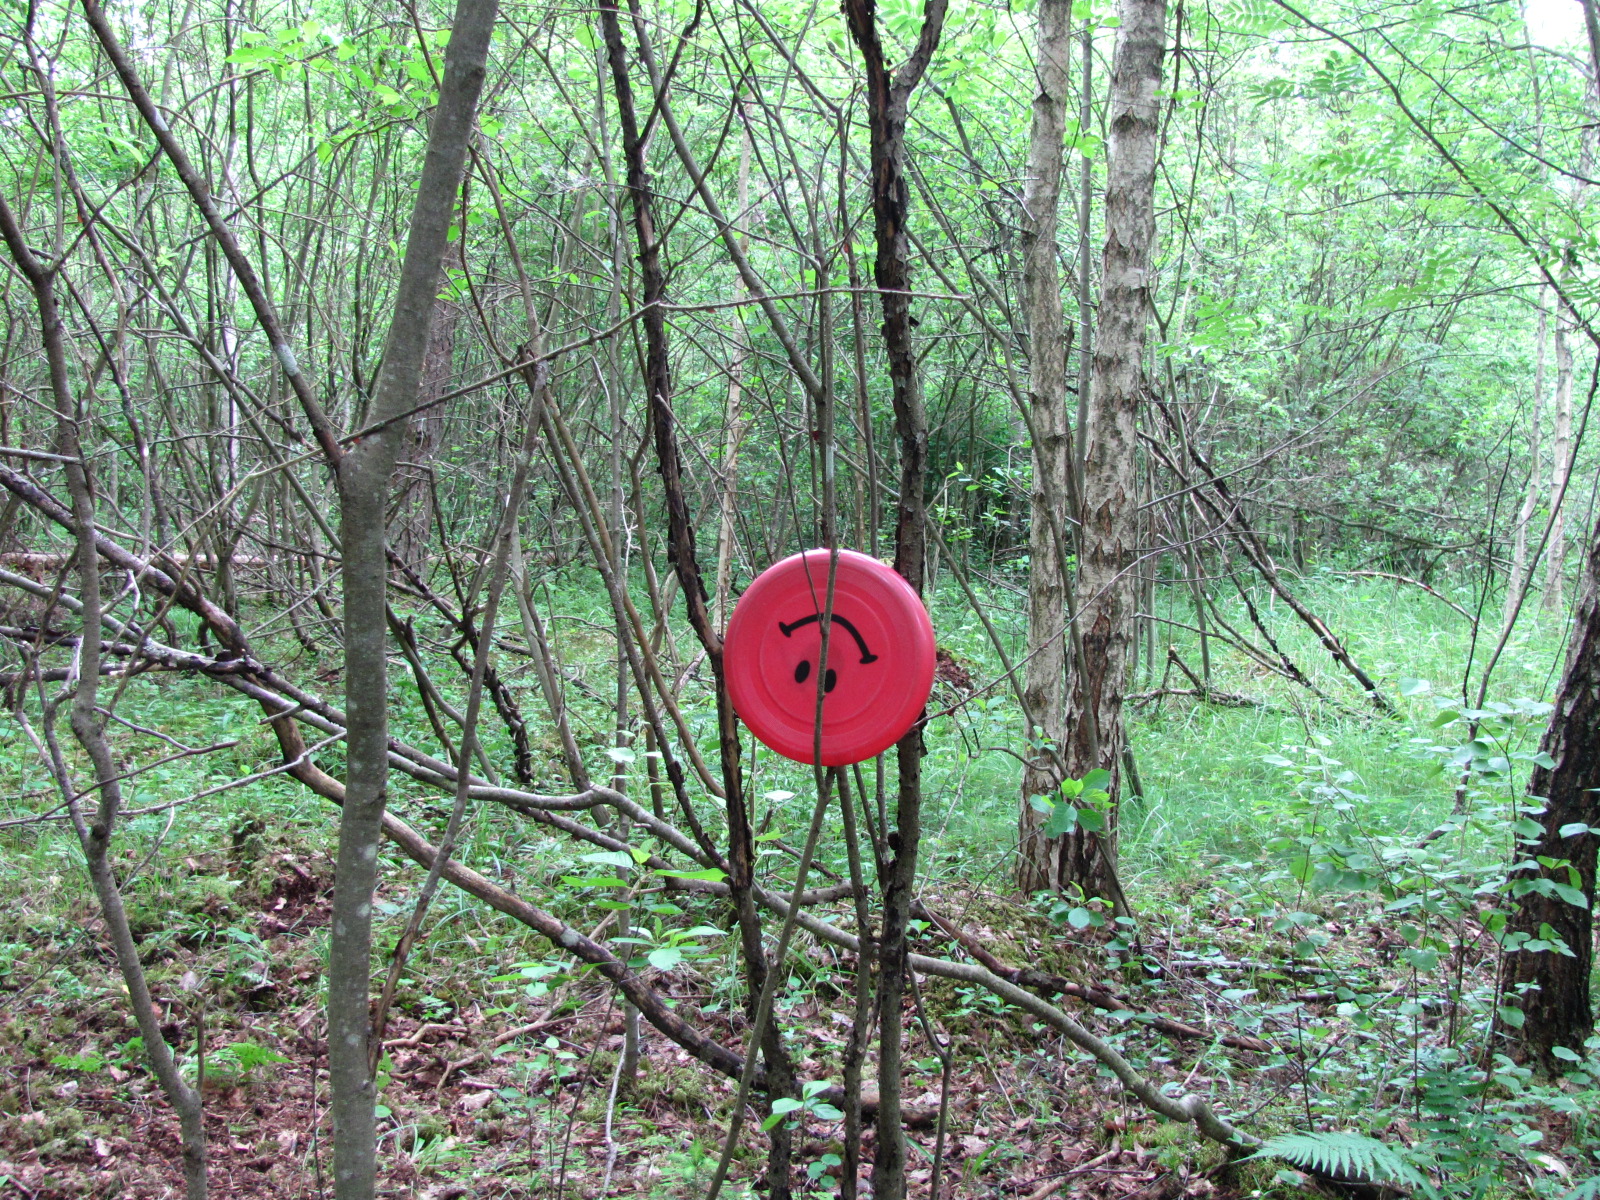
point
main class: Woodland
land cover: Pine dominated mixed woodland
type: hemiboreal forest and nemoral coniferous forest and mixed broadleaved-coniferous forest
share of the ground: > 75 %
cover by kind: coniferous forest trees 50 %, broadleaved forest trees 50 %
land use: Forestry
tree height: > 5 m
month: June
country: LV
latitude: 56.8937
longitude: 23.8532
